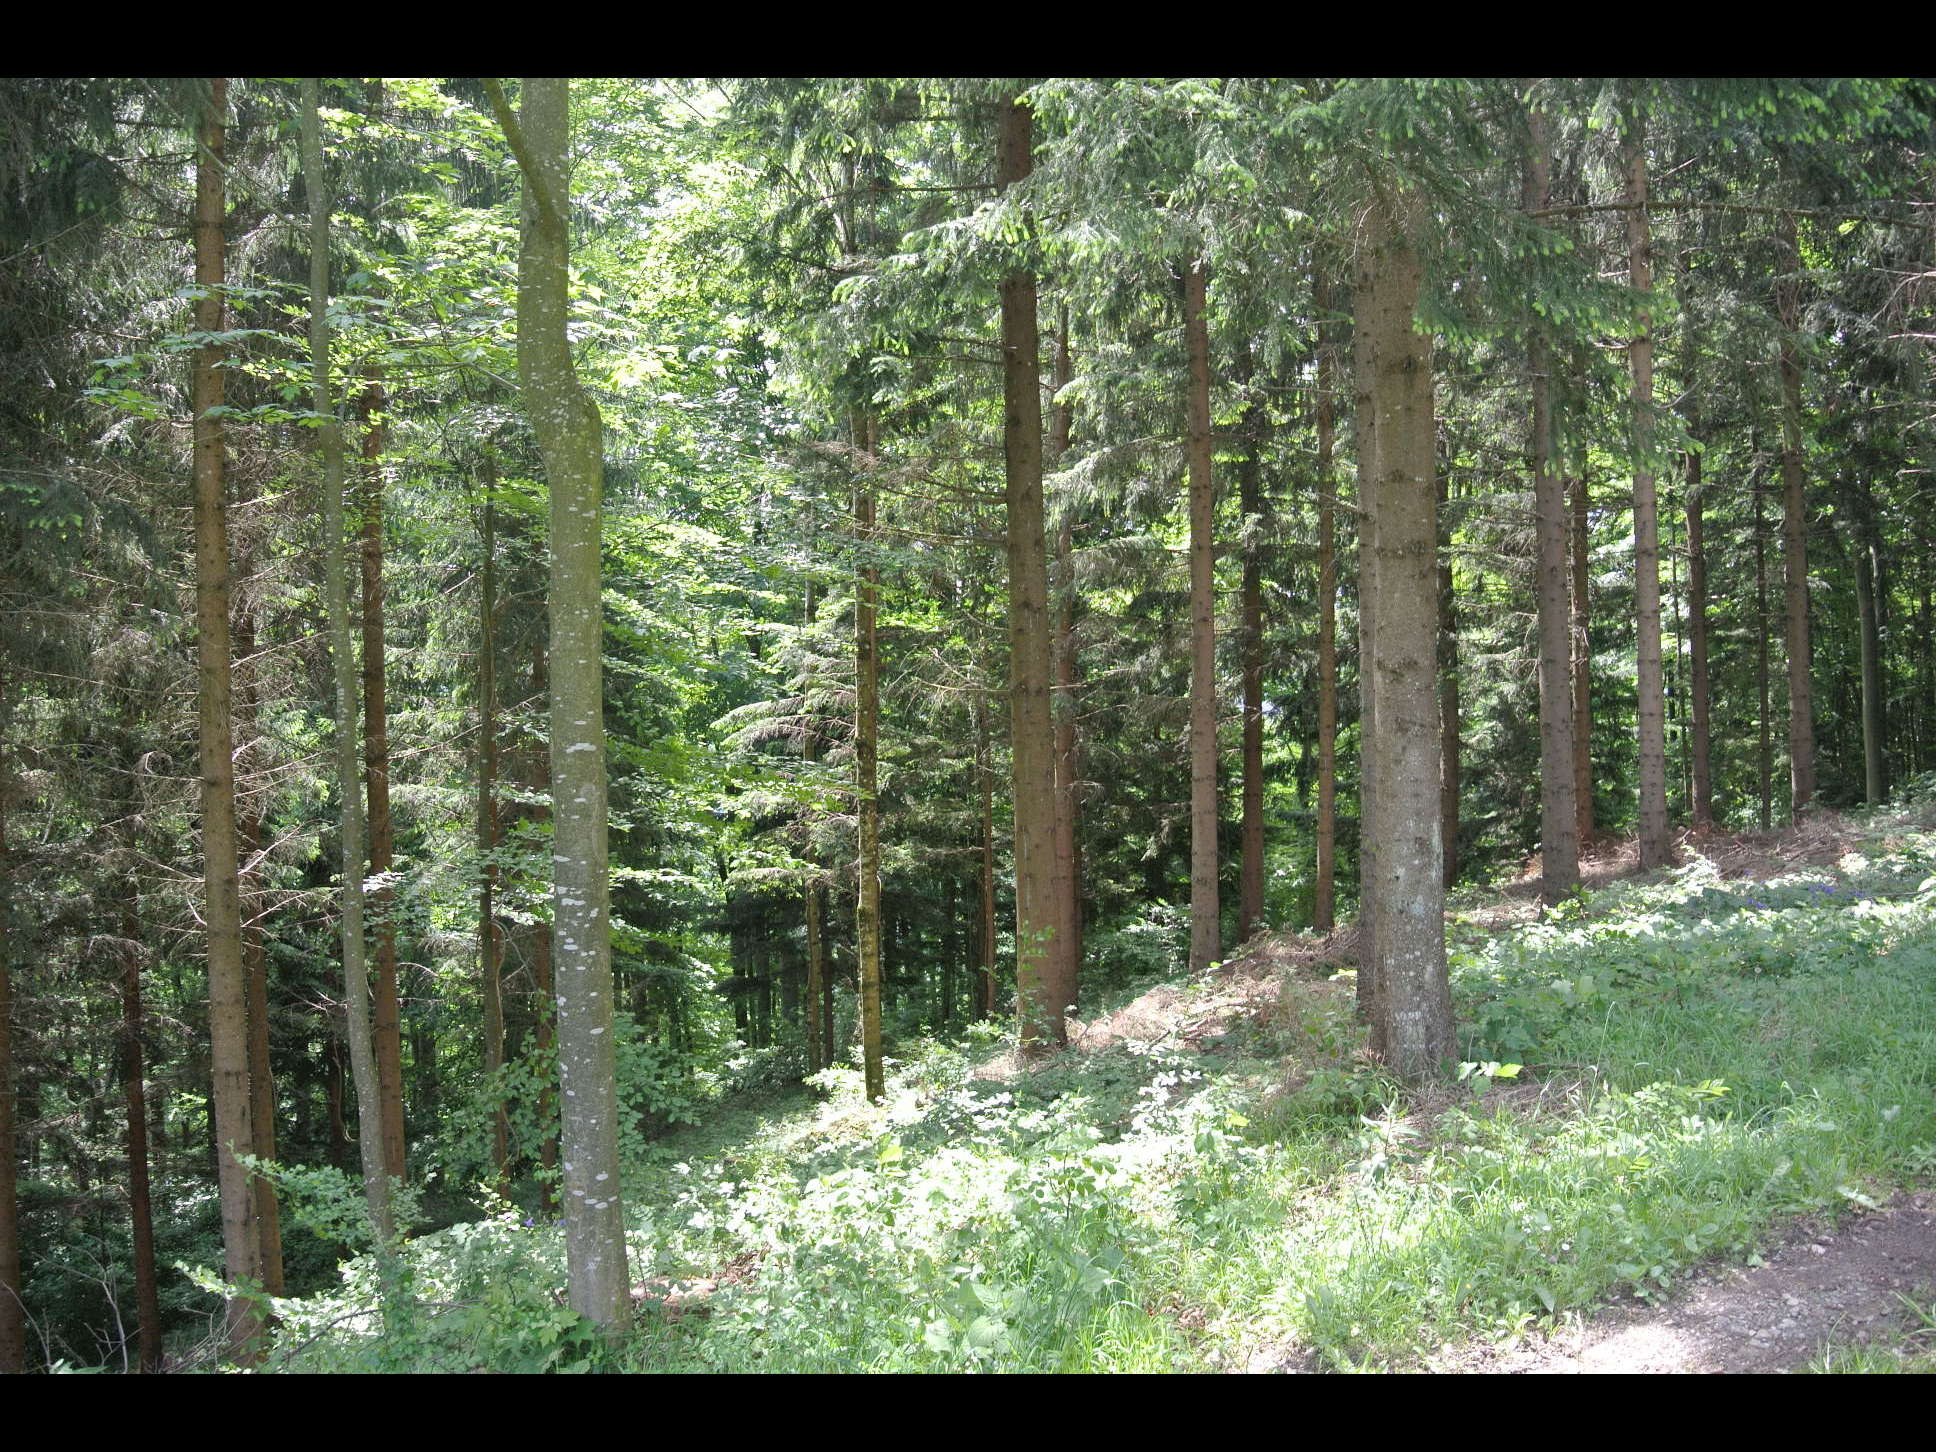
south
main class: Grassland
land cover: Grassland without tree/shrub cover
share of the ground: > 75 %
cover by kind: herbaceous plants 100 %
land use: Agriculture (excluding fallow land and kitchen gardens)
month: May
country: AT
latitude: 48.0163
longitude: 15.8079
